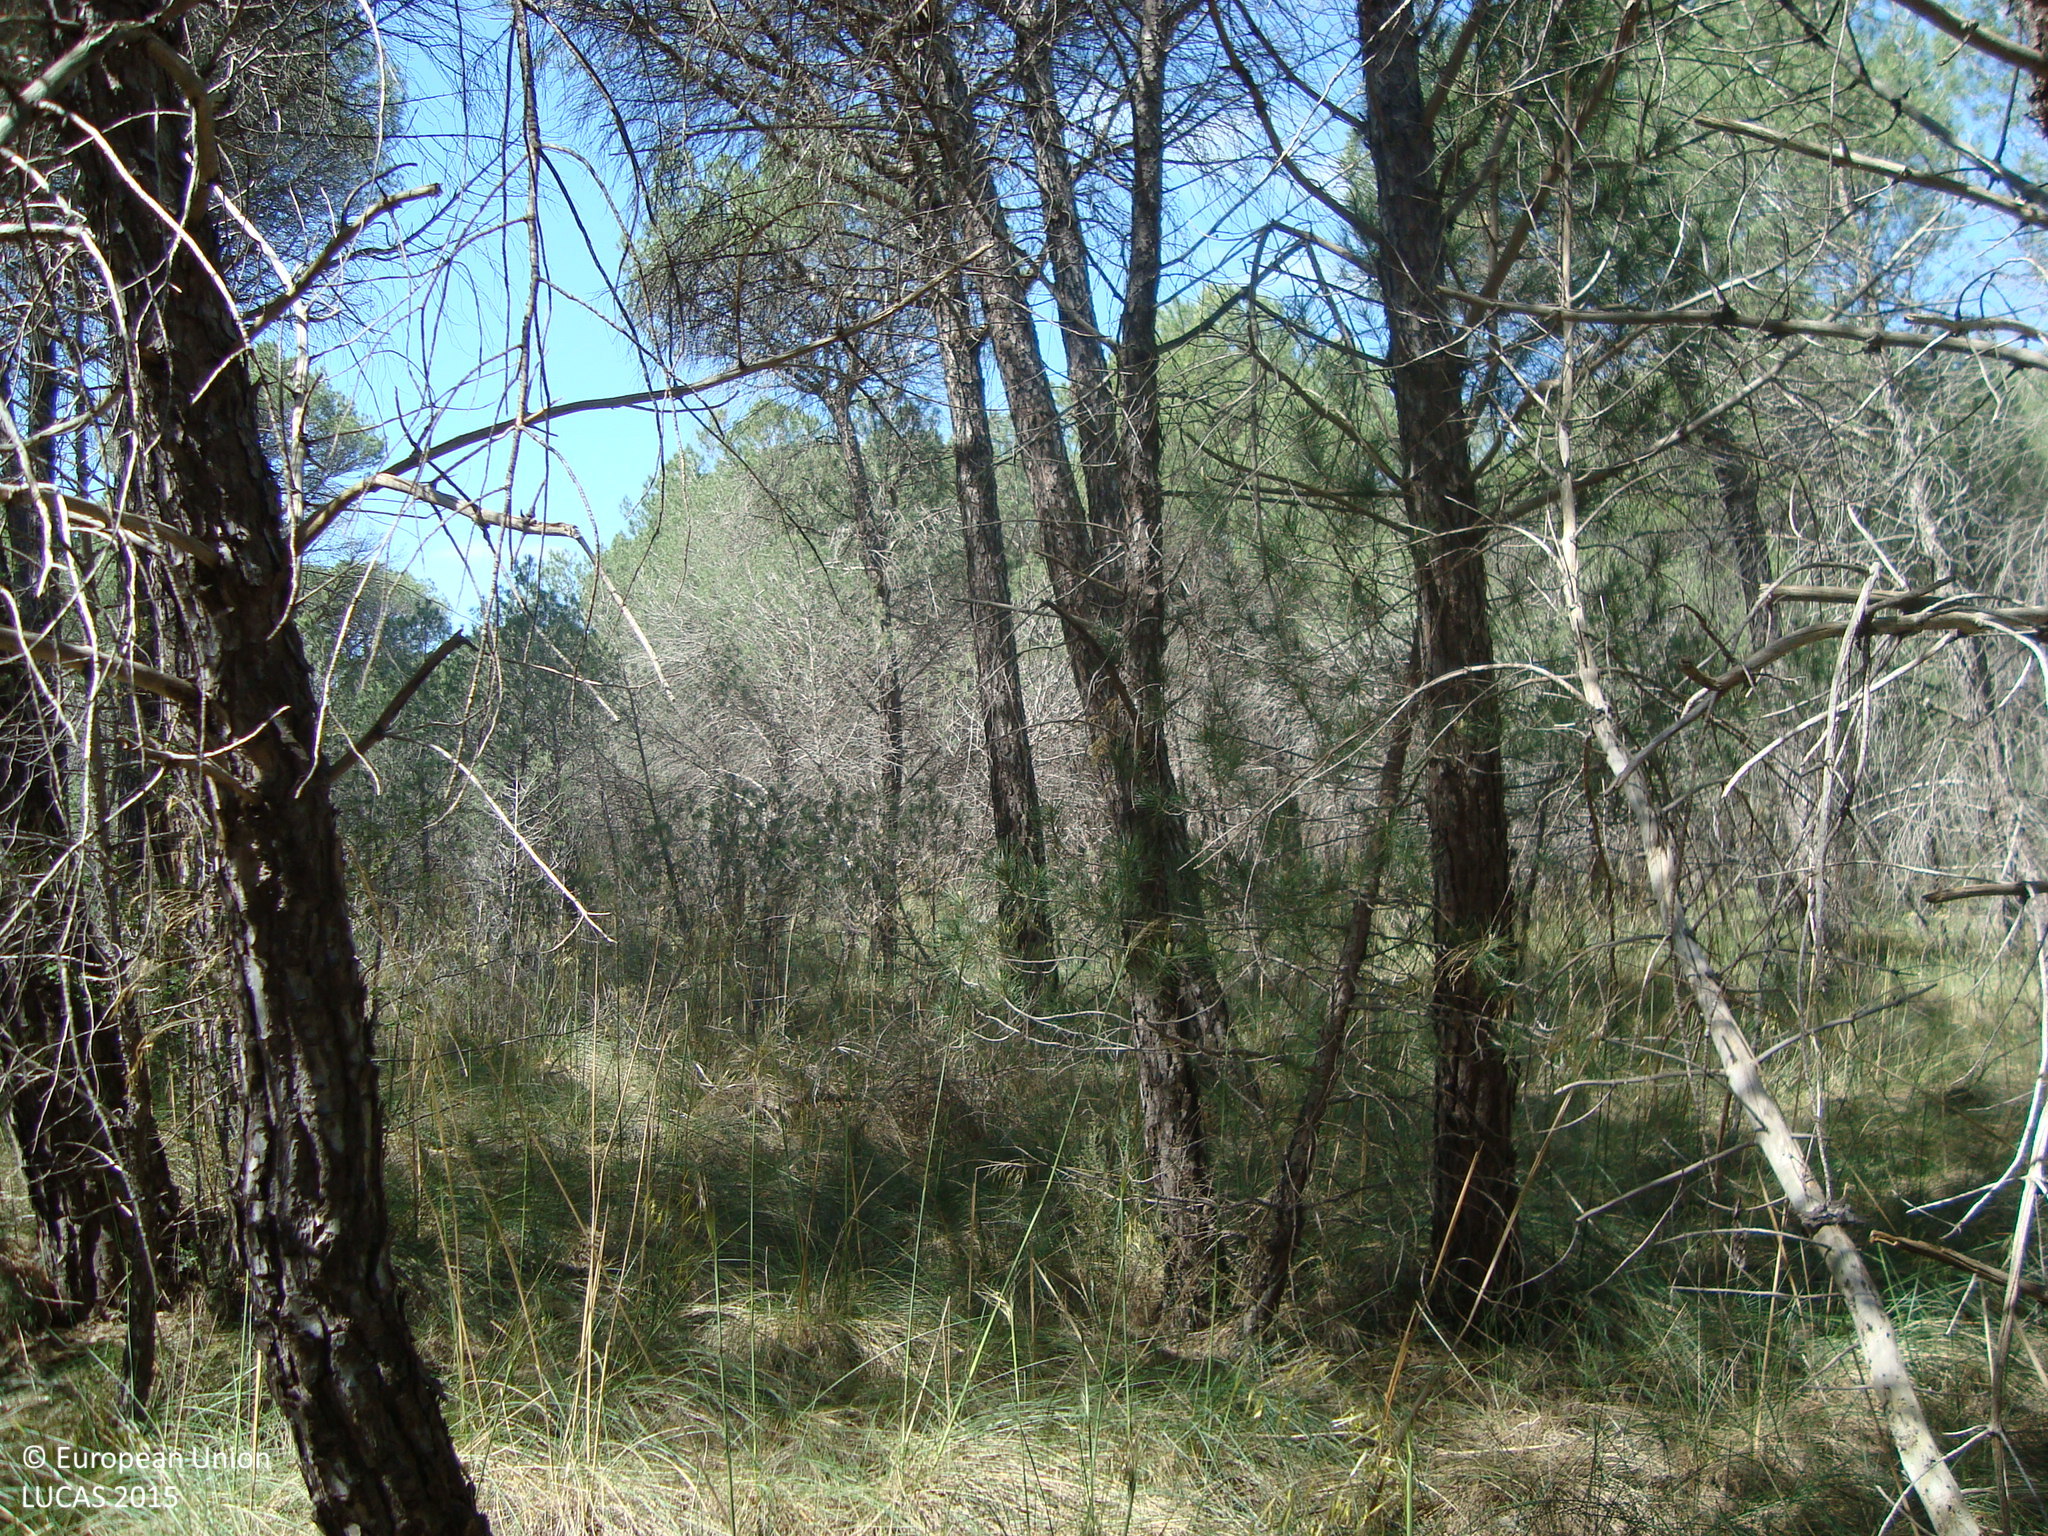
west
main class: Woodland
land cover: Pine dominated mixed woodland
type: coniferous forest of the mediterranean region
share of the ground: > 75 %
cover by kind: coniferous forest trees 55 %, broadleaved forest trees 25 %, shrubs 10 %, herbaceous plants 10 %
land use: Semi-natural and natural areas not in use
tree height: > 5 m
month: May
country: ES
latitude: 41.6345
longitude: -4.1647
